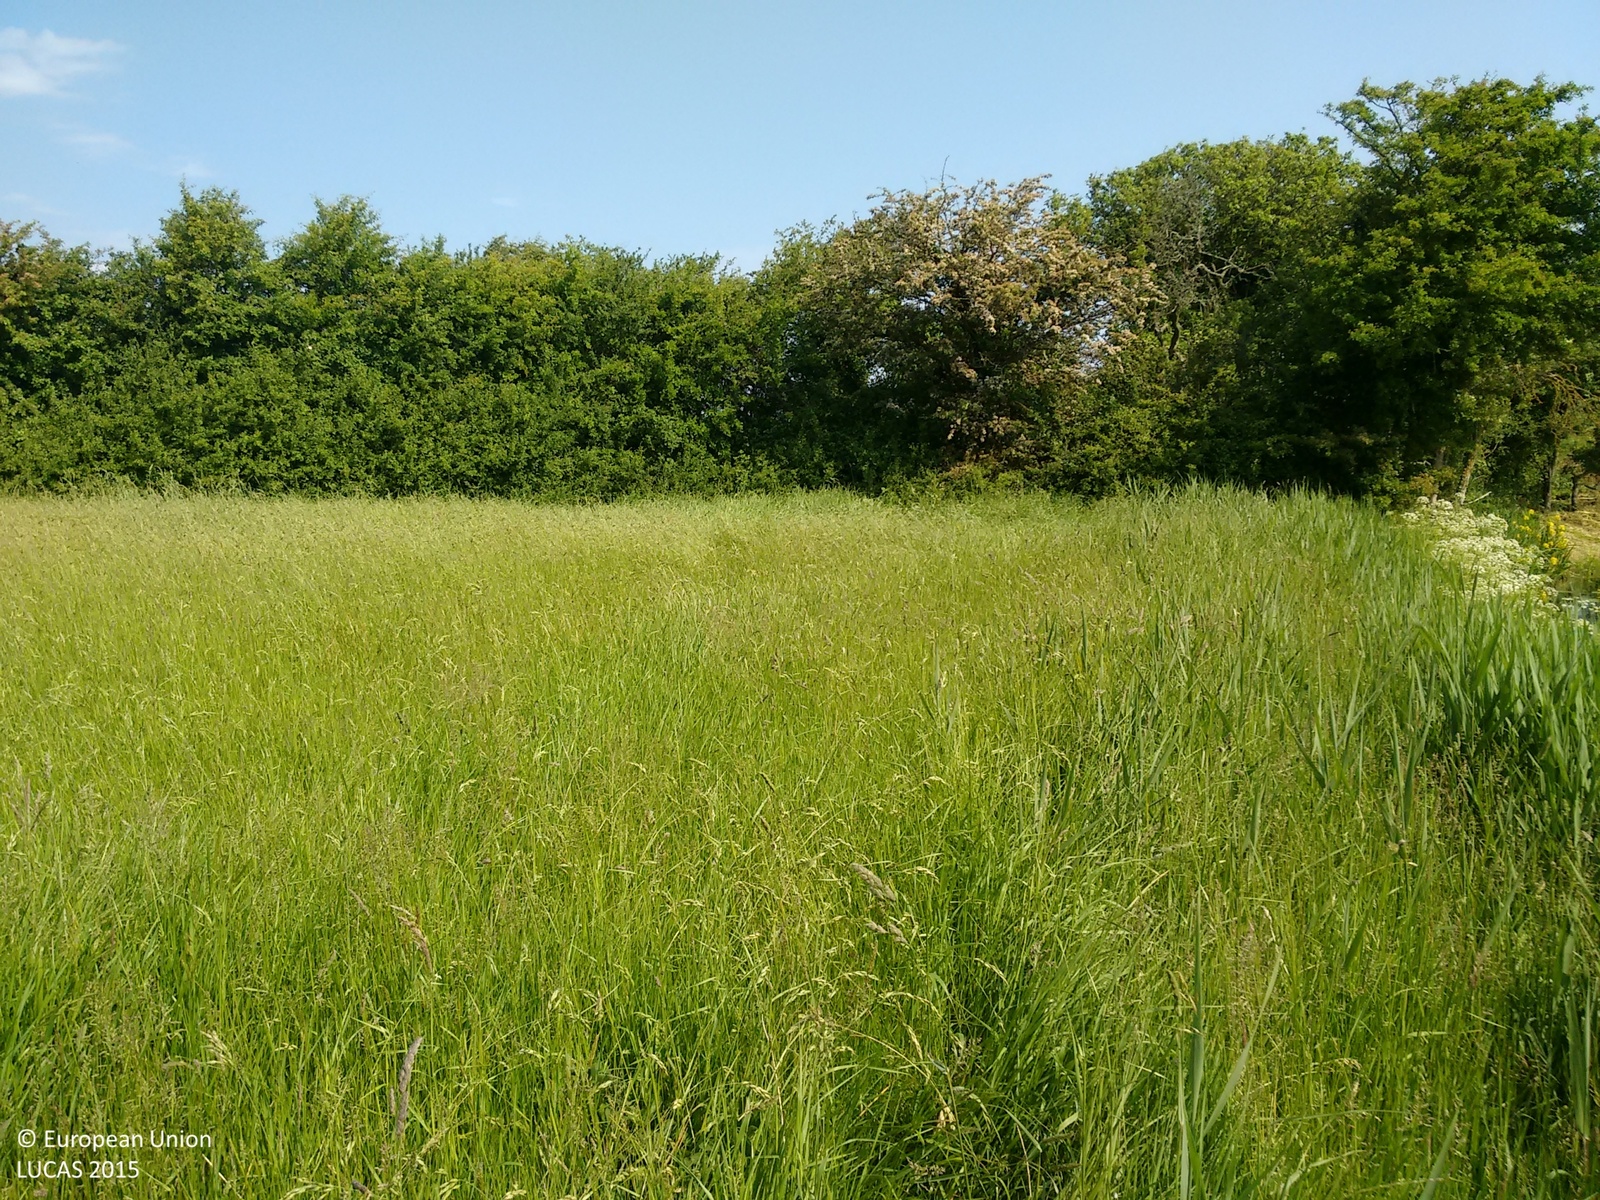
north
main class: Grassland
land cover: Grassland without tree/shrub cover
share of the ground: > 75 %
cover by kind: herbaceous plants 100 %
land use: Agriculture (excluding fallow land and kitchen gardens)
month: June
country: GB
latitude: 51.0336
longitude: 0.6906
